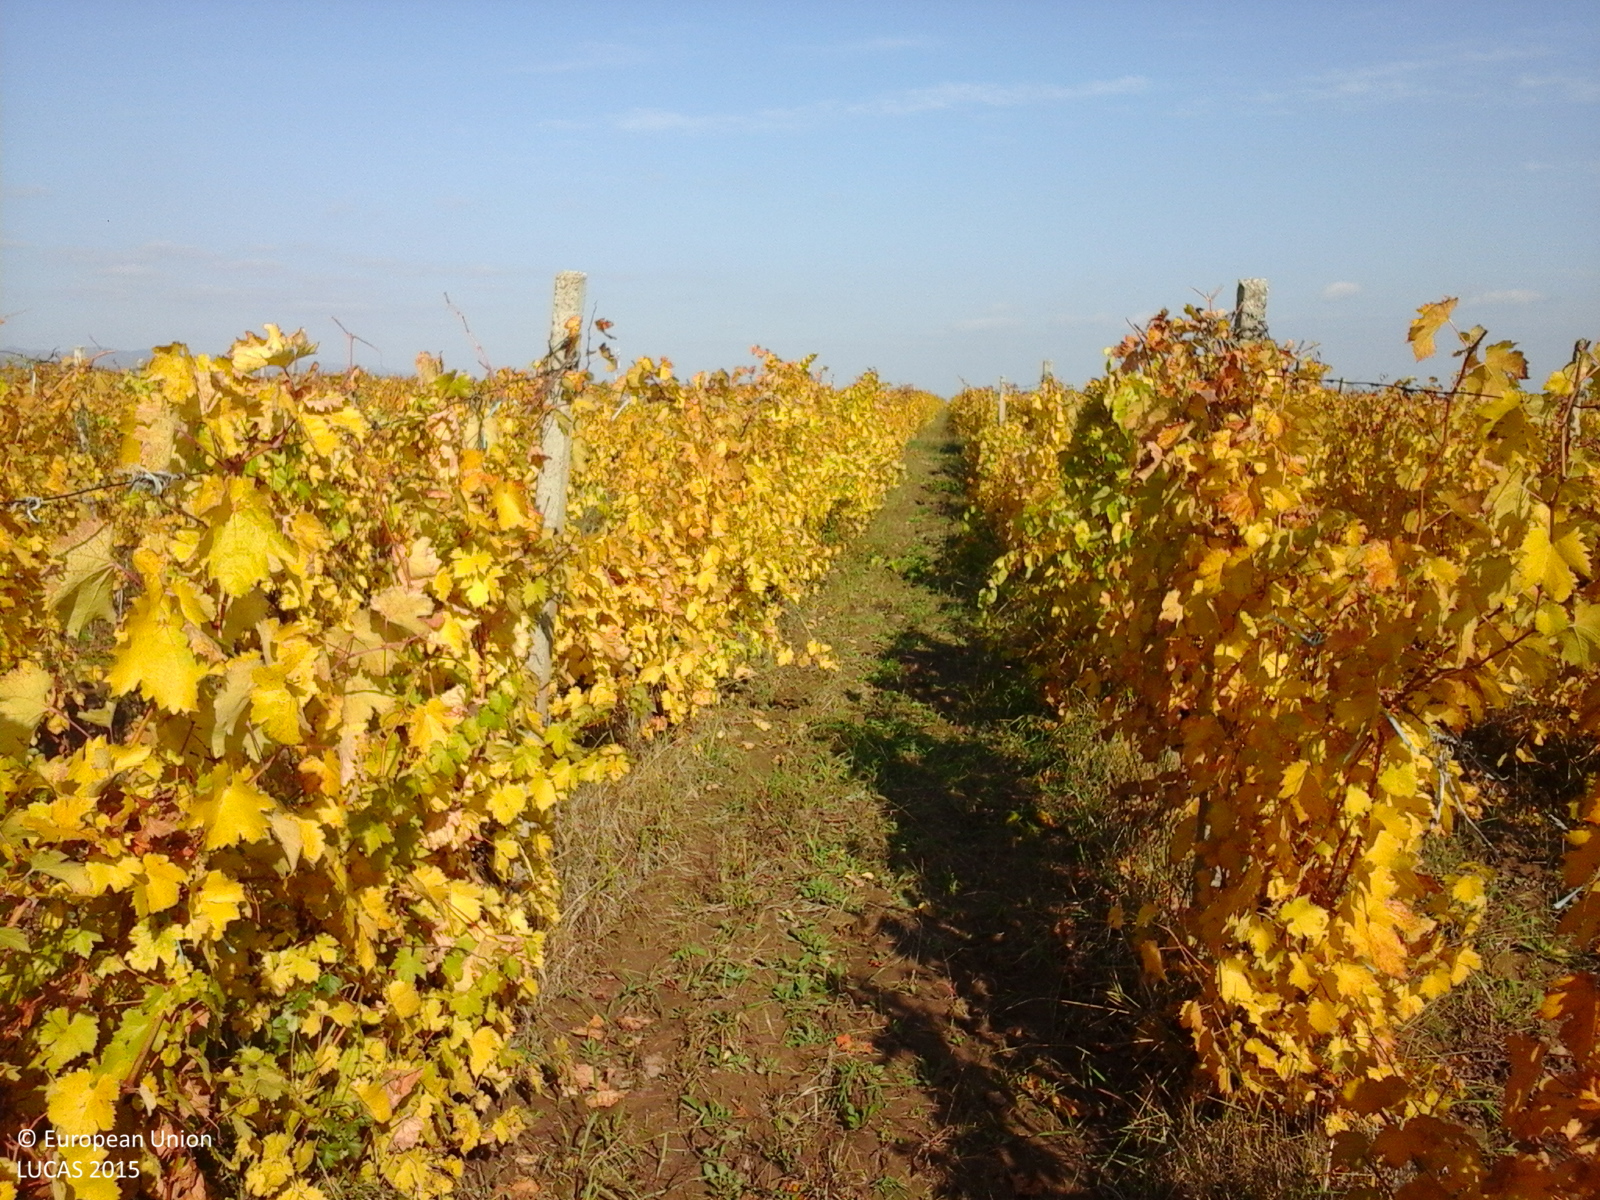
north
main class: Cropland
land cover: Vineyards
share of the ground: > 75 %
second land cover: Other bare soil
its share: > 75 %
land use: Agriculture (excluding fallow land and kitchen gardens)
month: October
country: RO
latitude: 45.5690
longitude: 27.0944
